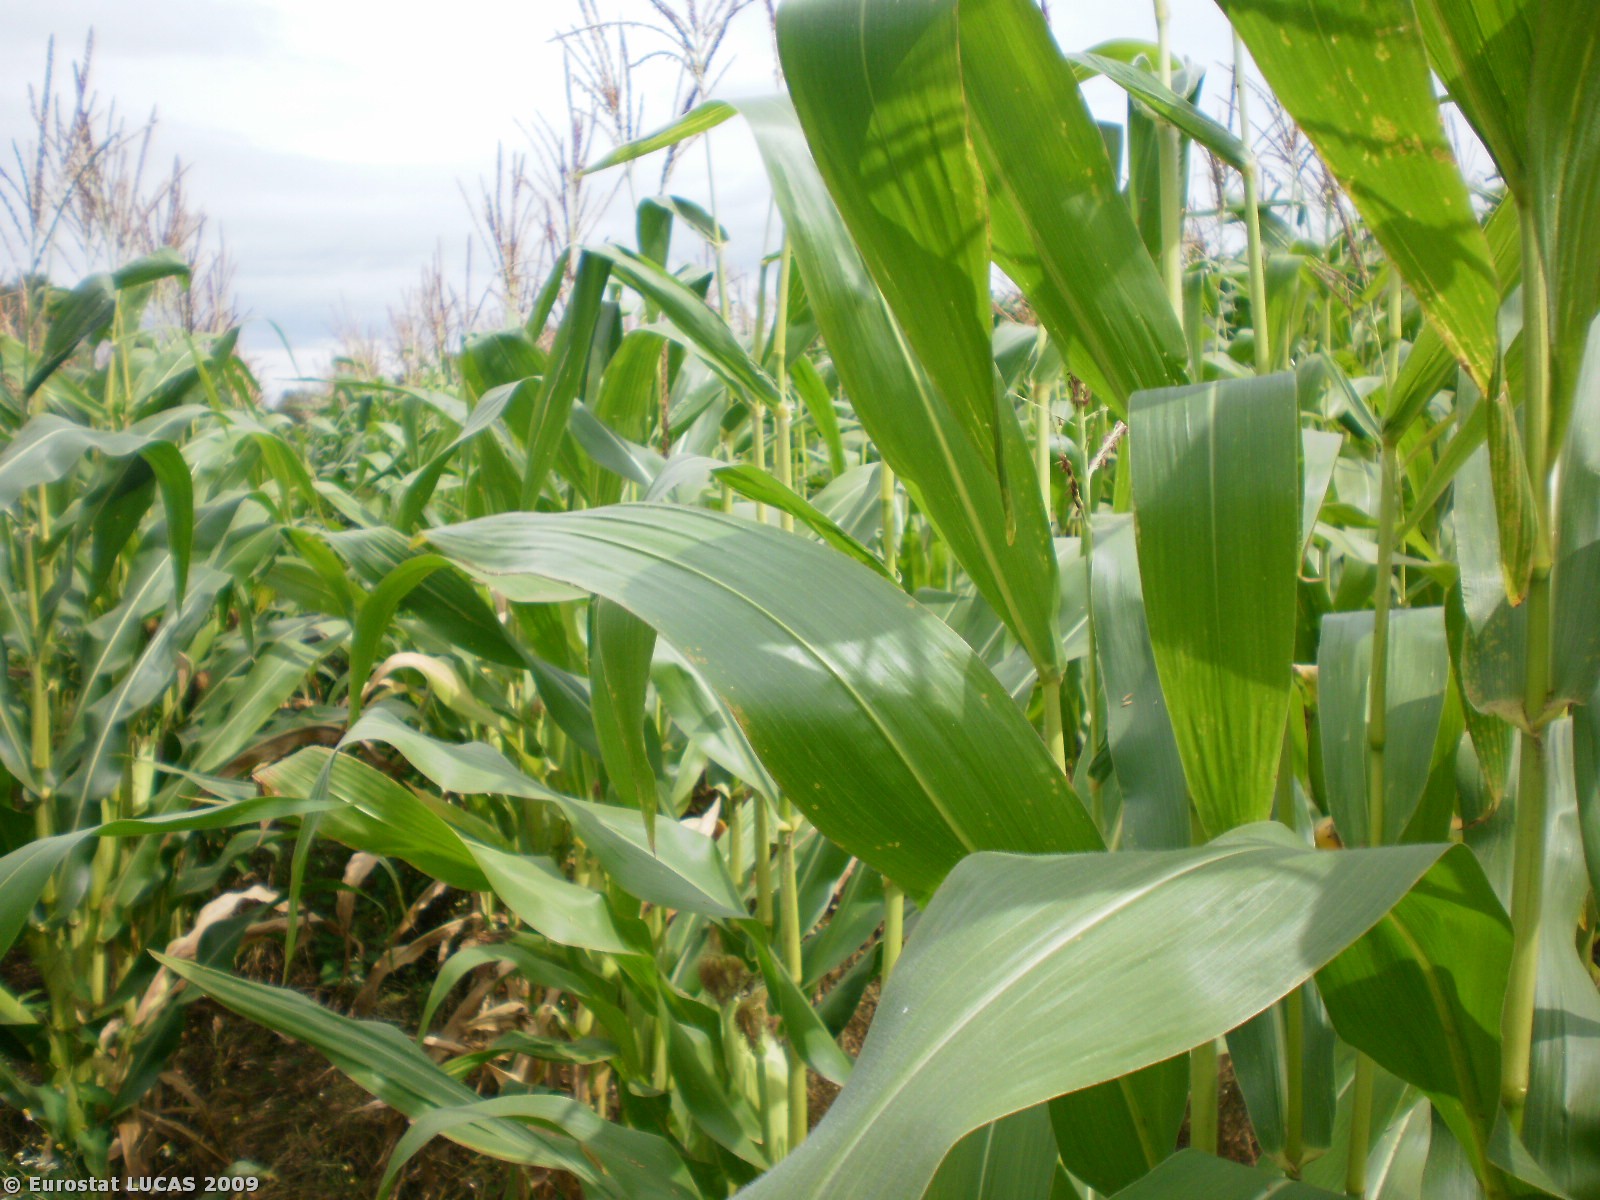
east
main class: Cropland
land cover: Maize
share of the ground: > 75 %
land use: Agriculture (excluding fallow land and kitchen gardens)
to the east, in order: Maize; Grassland without tree/shrub cover; Paved roads, cycling and walking lanes; Grass margins; Fences; Grassland without tree/shrub cover; Artificial constructions in urban areas; Grassland with sparse tree/shrub cover
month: August
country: BE
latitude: 50.4412
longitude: 5.5911
